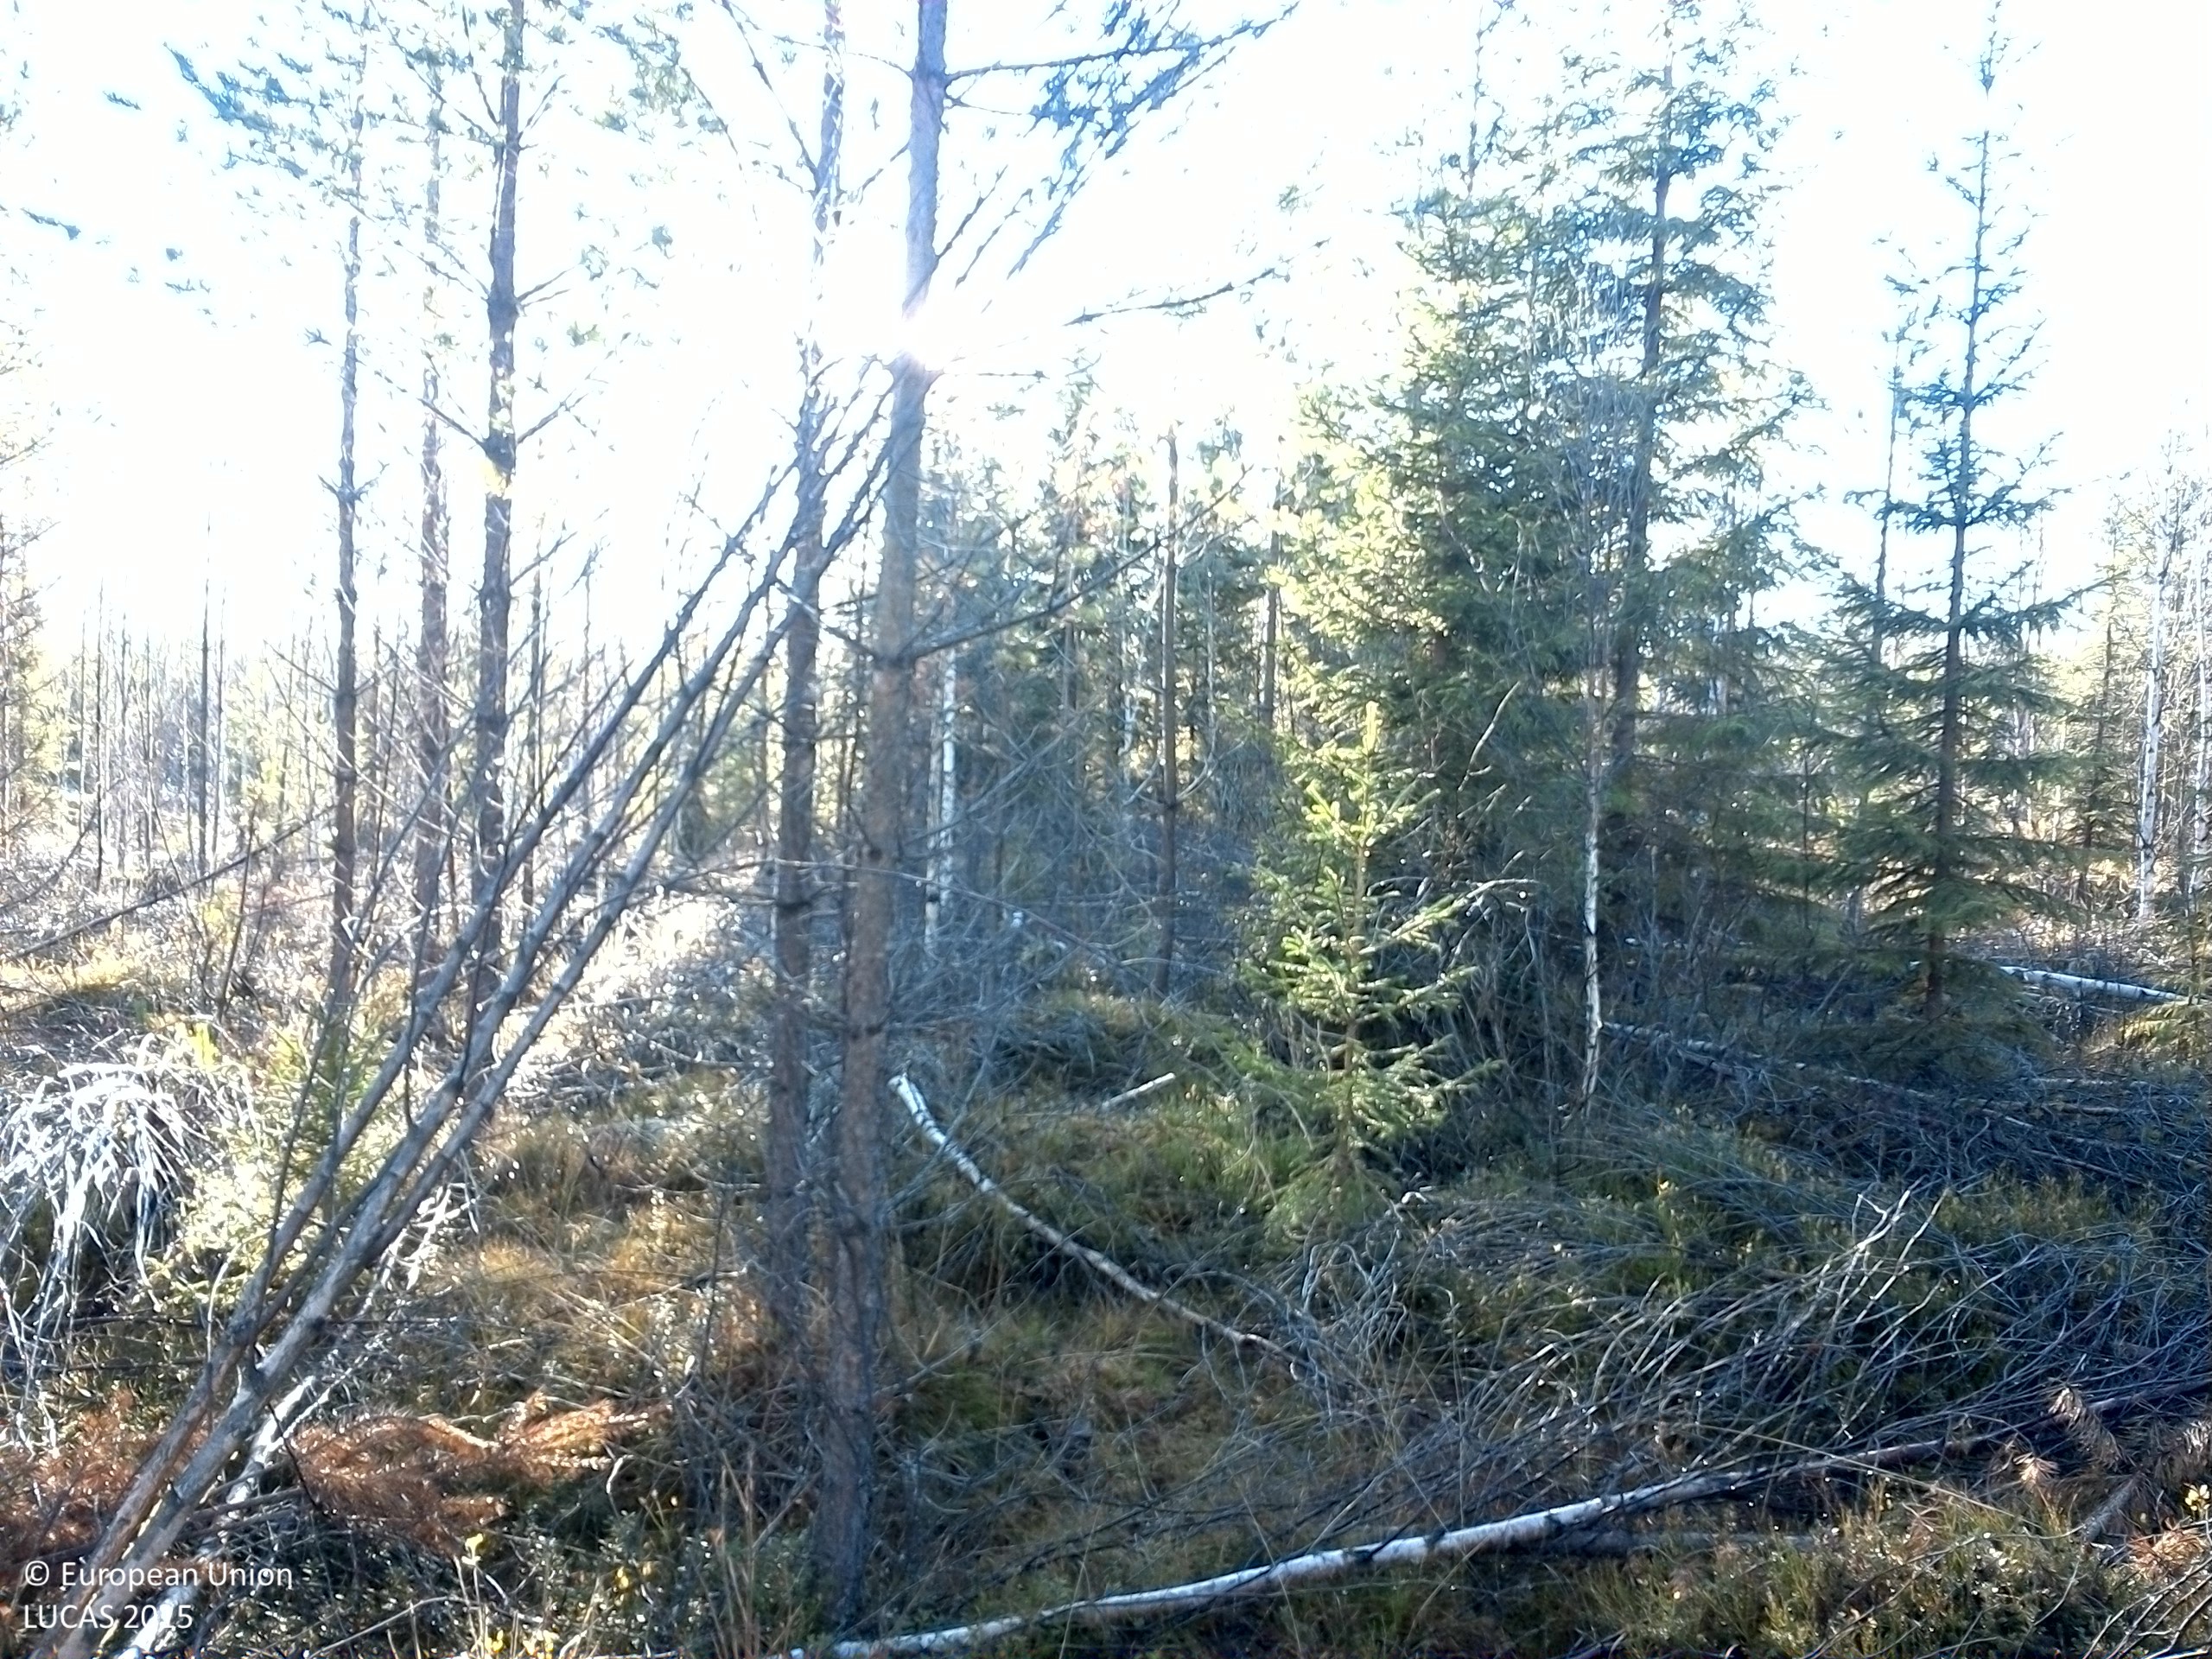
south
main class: Woodland
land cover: Pine dominated coniferous woodland
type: boreal forest
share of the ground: 25 - 50 %
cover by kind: shrubs 40 %, coniferous forest trees 35 %, lichens and mosses 20 %, broadleaved forest trees 5 %
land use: Forestry
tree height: < 5 m
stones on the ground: > 50 %
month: October
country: SE
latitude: 63.7433
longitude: 15.9498
